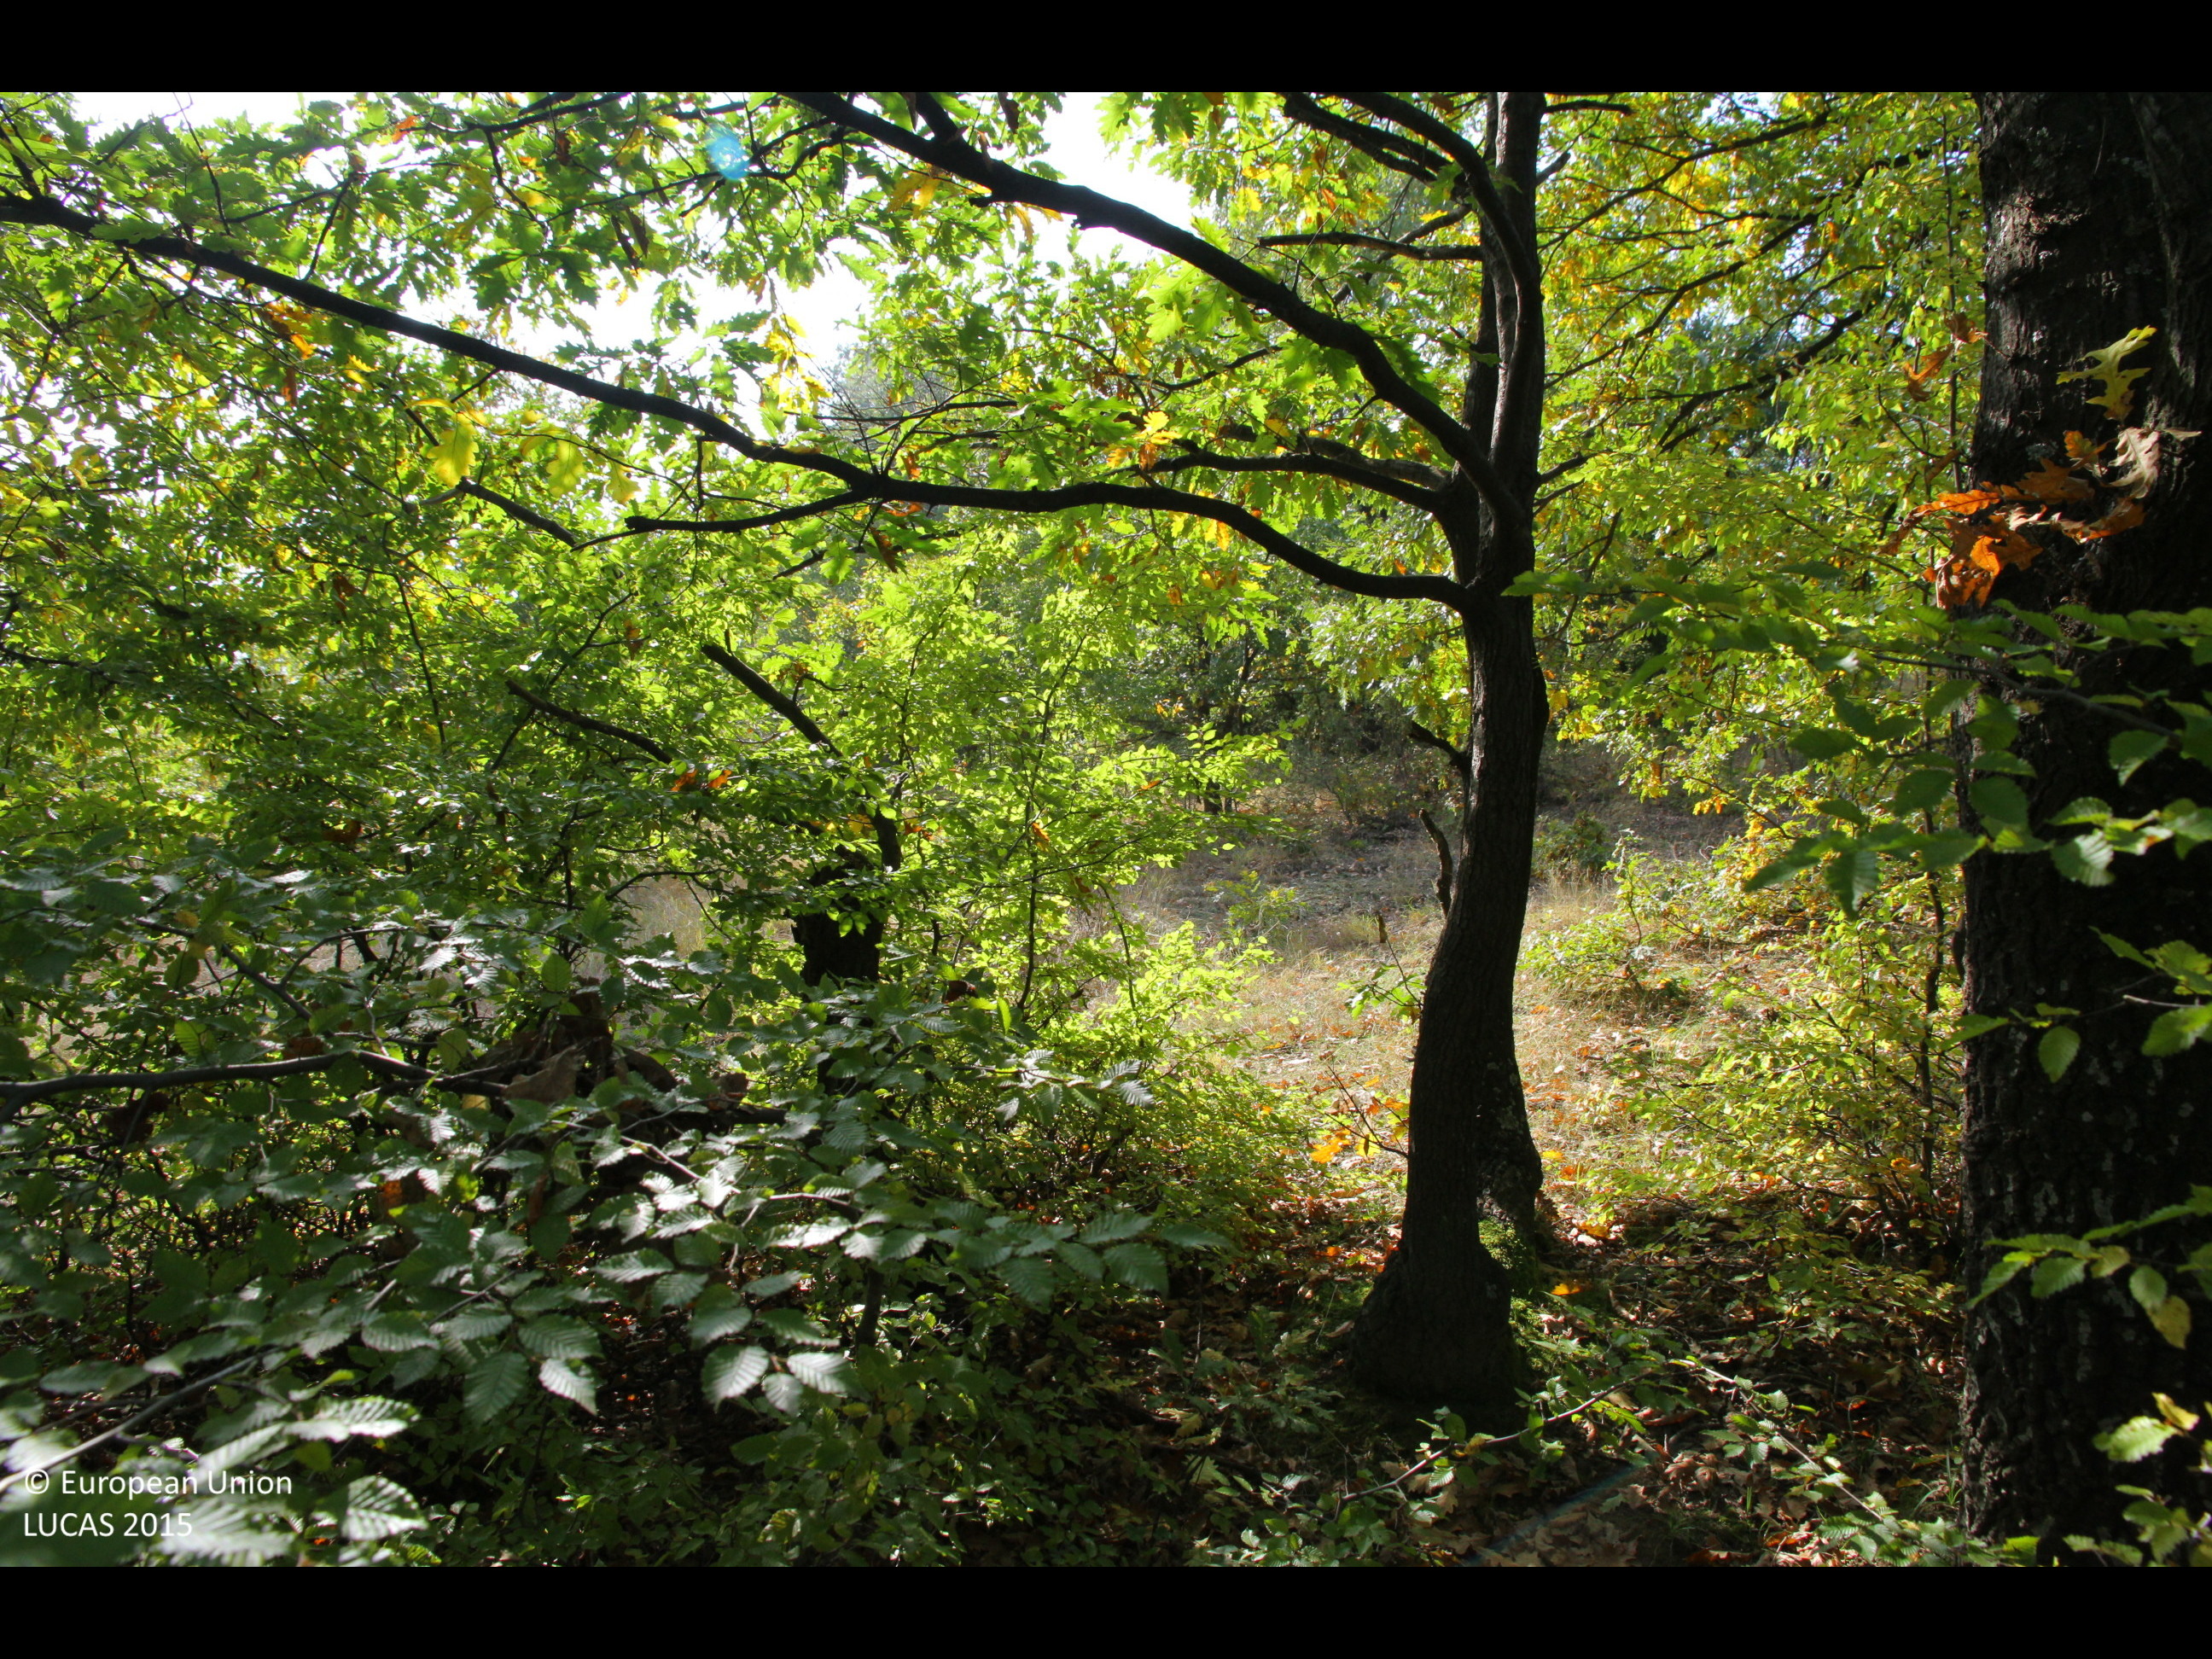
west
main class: Woodland
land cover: Broadleaved woodland
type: thermophilous deciduous forest
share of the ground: > 75 %
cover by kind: broadleaved forest trees 90 %, herbaceous plants 5 %, unconsolidated bare surface 5 %
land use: Forestry
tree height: > 5 m
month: October
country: BG
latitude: 42.9676
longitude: 26.9175
